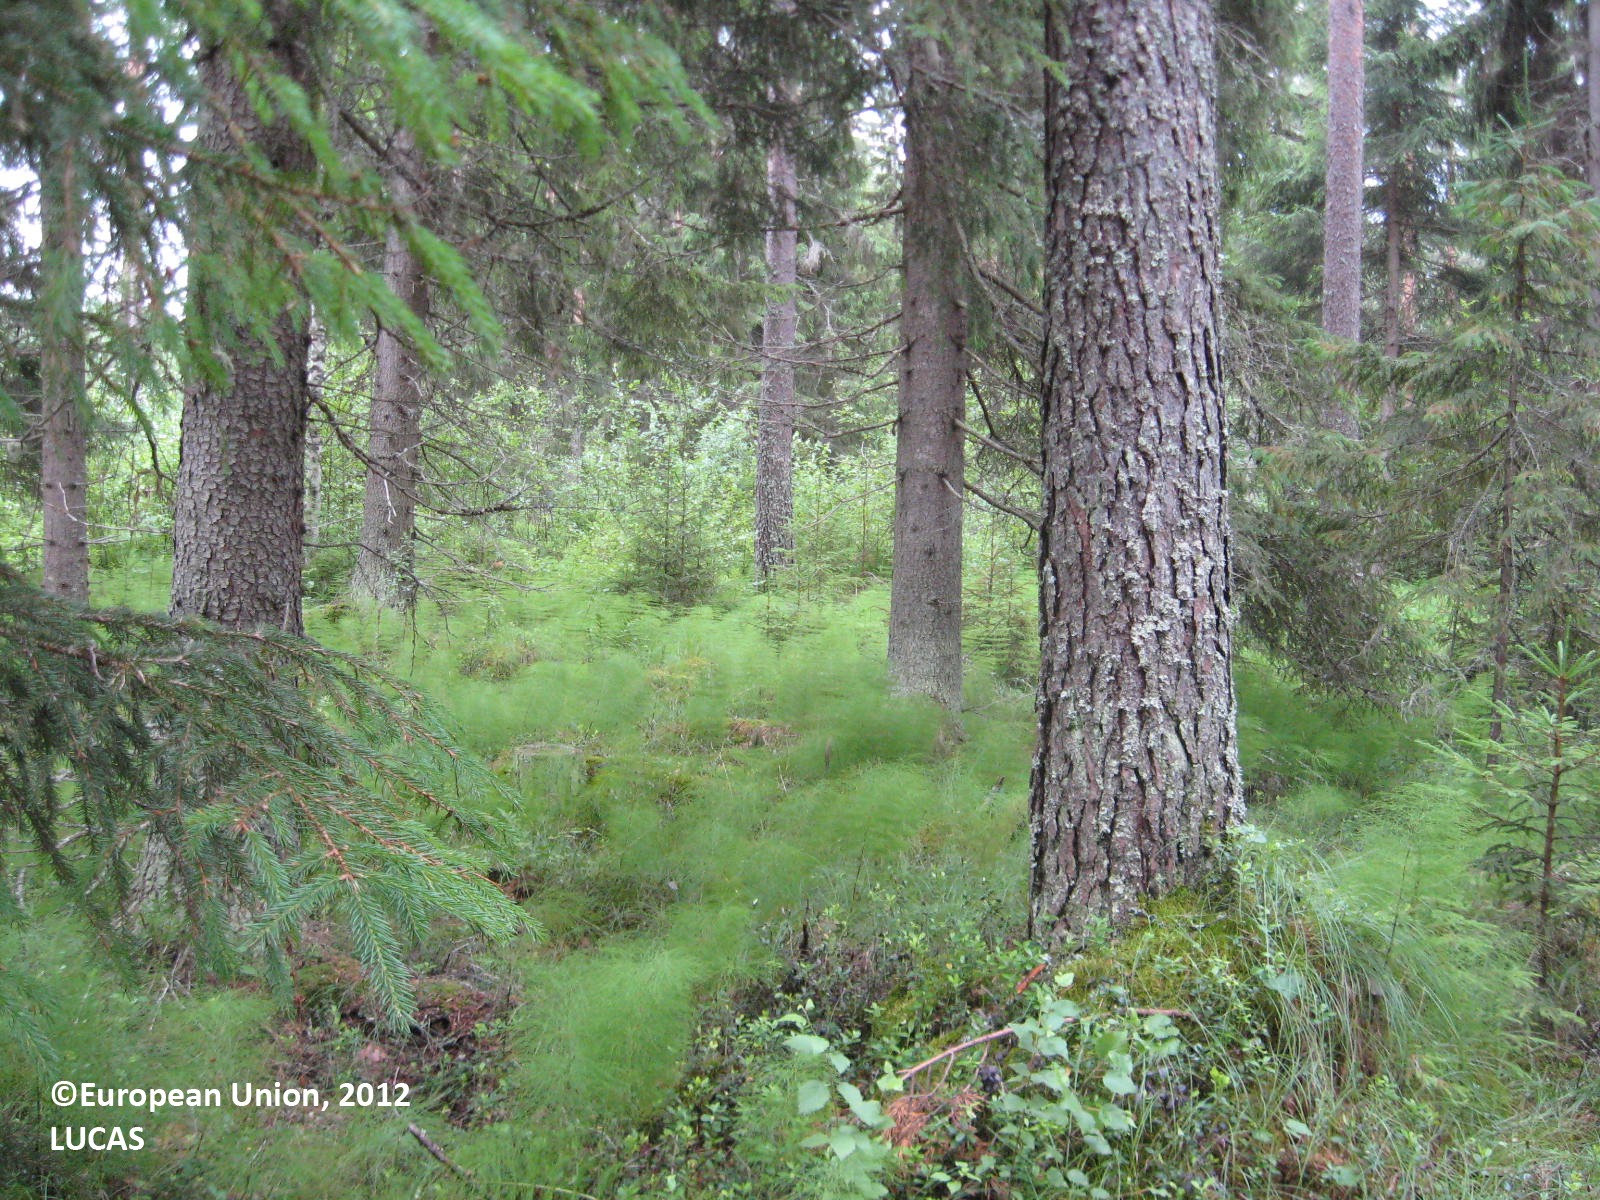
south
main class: Woodland
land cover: Other coniferous woodland
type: boreal forest
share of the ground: > 75 %
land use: Forestry
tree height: > 5 m
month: July
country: FI
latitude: 62.3588
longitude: 21.6583
